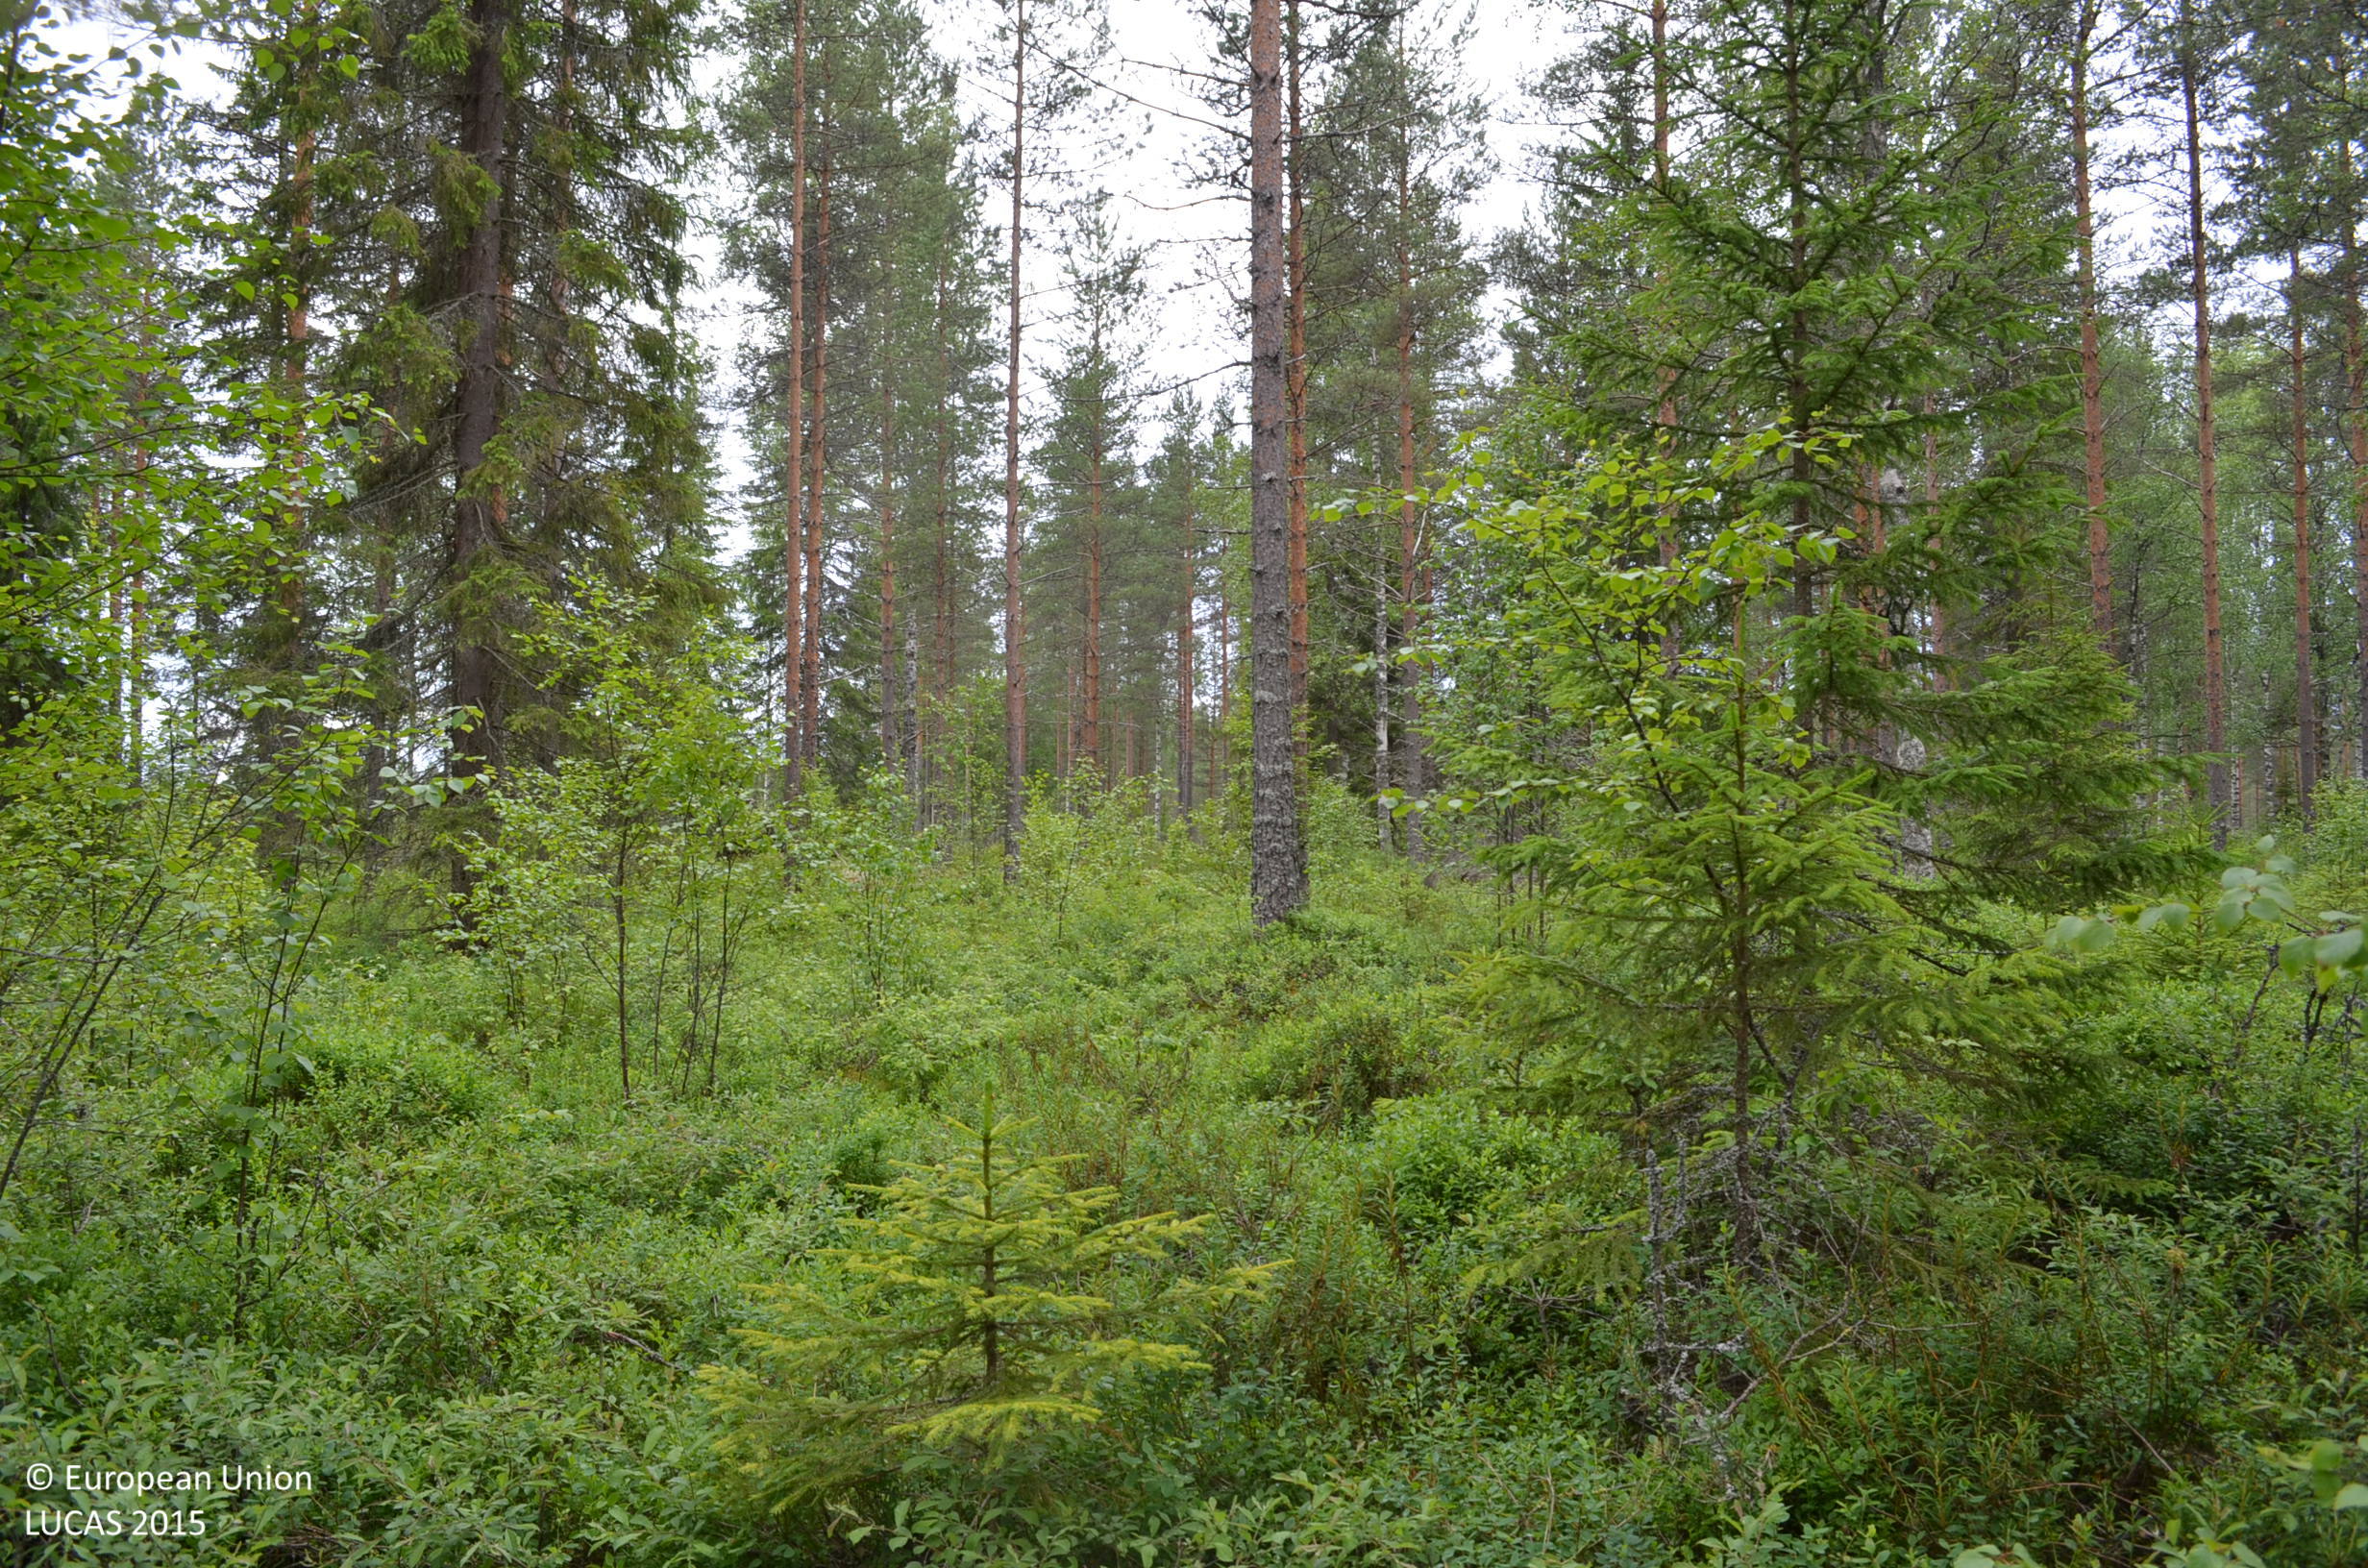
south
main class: Woodland
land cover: Pine dominated coniferous woodland
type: boreal forest
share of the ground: 50 - 75 %
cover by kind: coniferous forest trees 55 %, shrubs 35 %, broadleaved forest trees 10 %
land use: Forestry
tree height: > 5 m
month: July
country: FI
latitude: 62.2722
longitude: 23.5405
